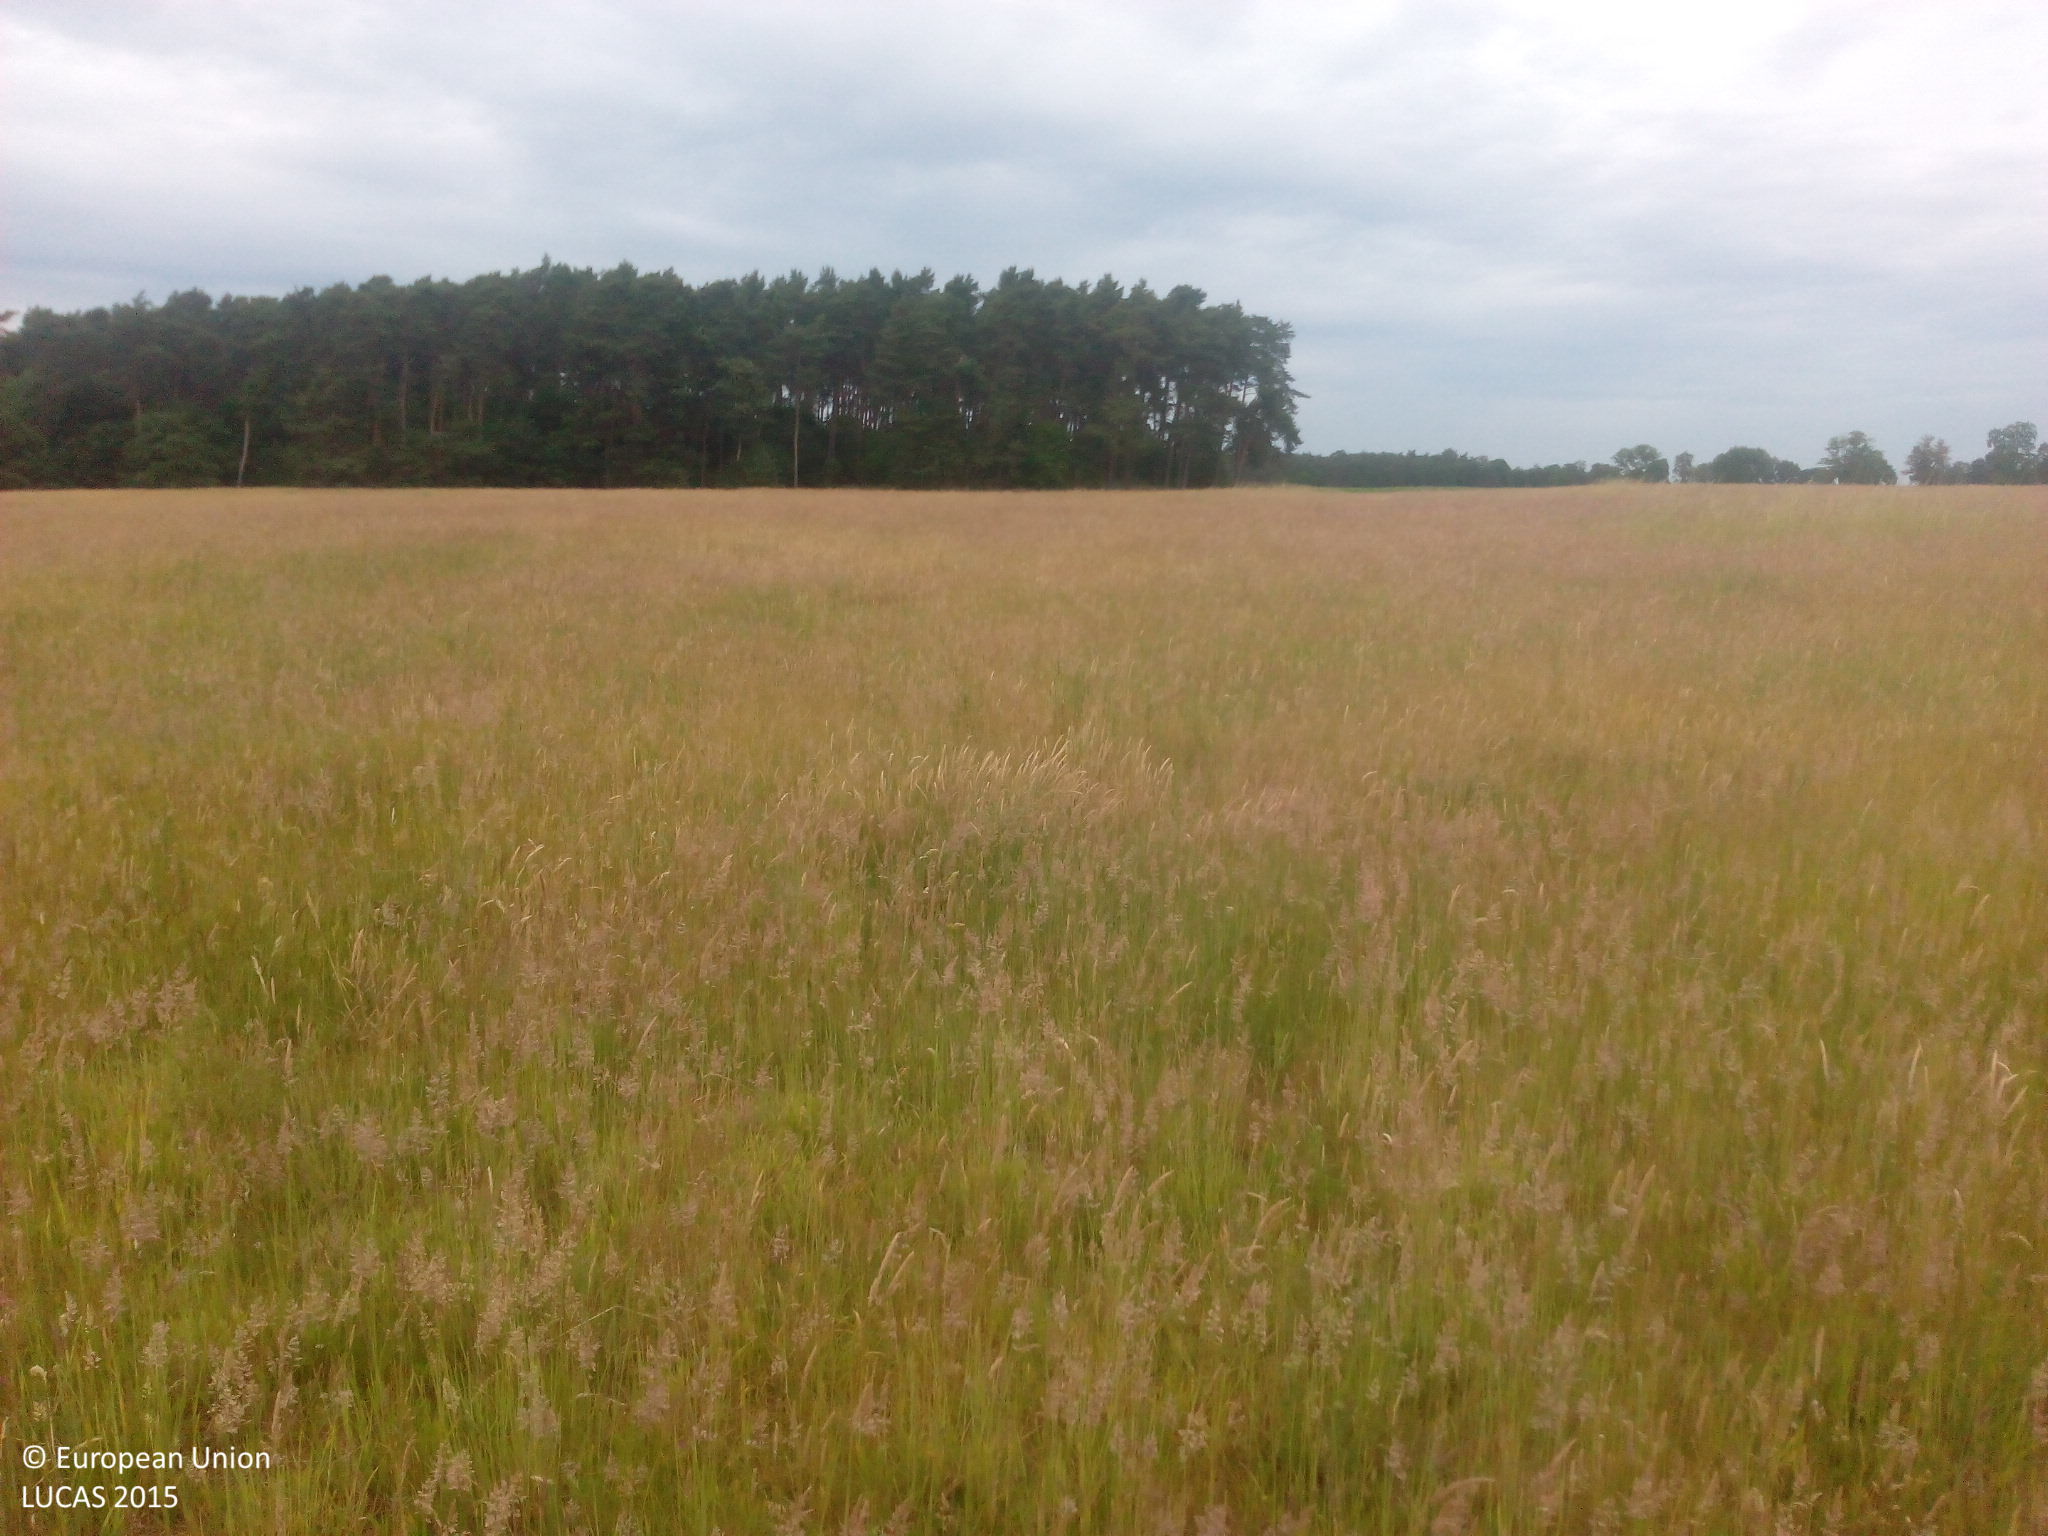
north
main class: Grassland
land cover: Grassland without tree/shrub cover
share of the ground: > 75 %
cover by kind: herbaceous plants 100 %
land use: Agriculture (excluding fallow land and kitchen gardens)
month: June
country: DE
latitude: 52.7089
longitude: 12.5898
